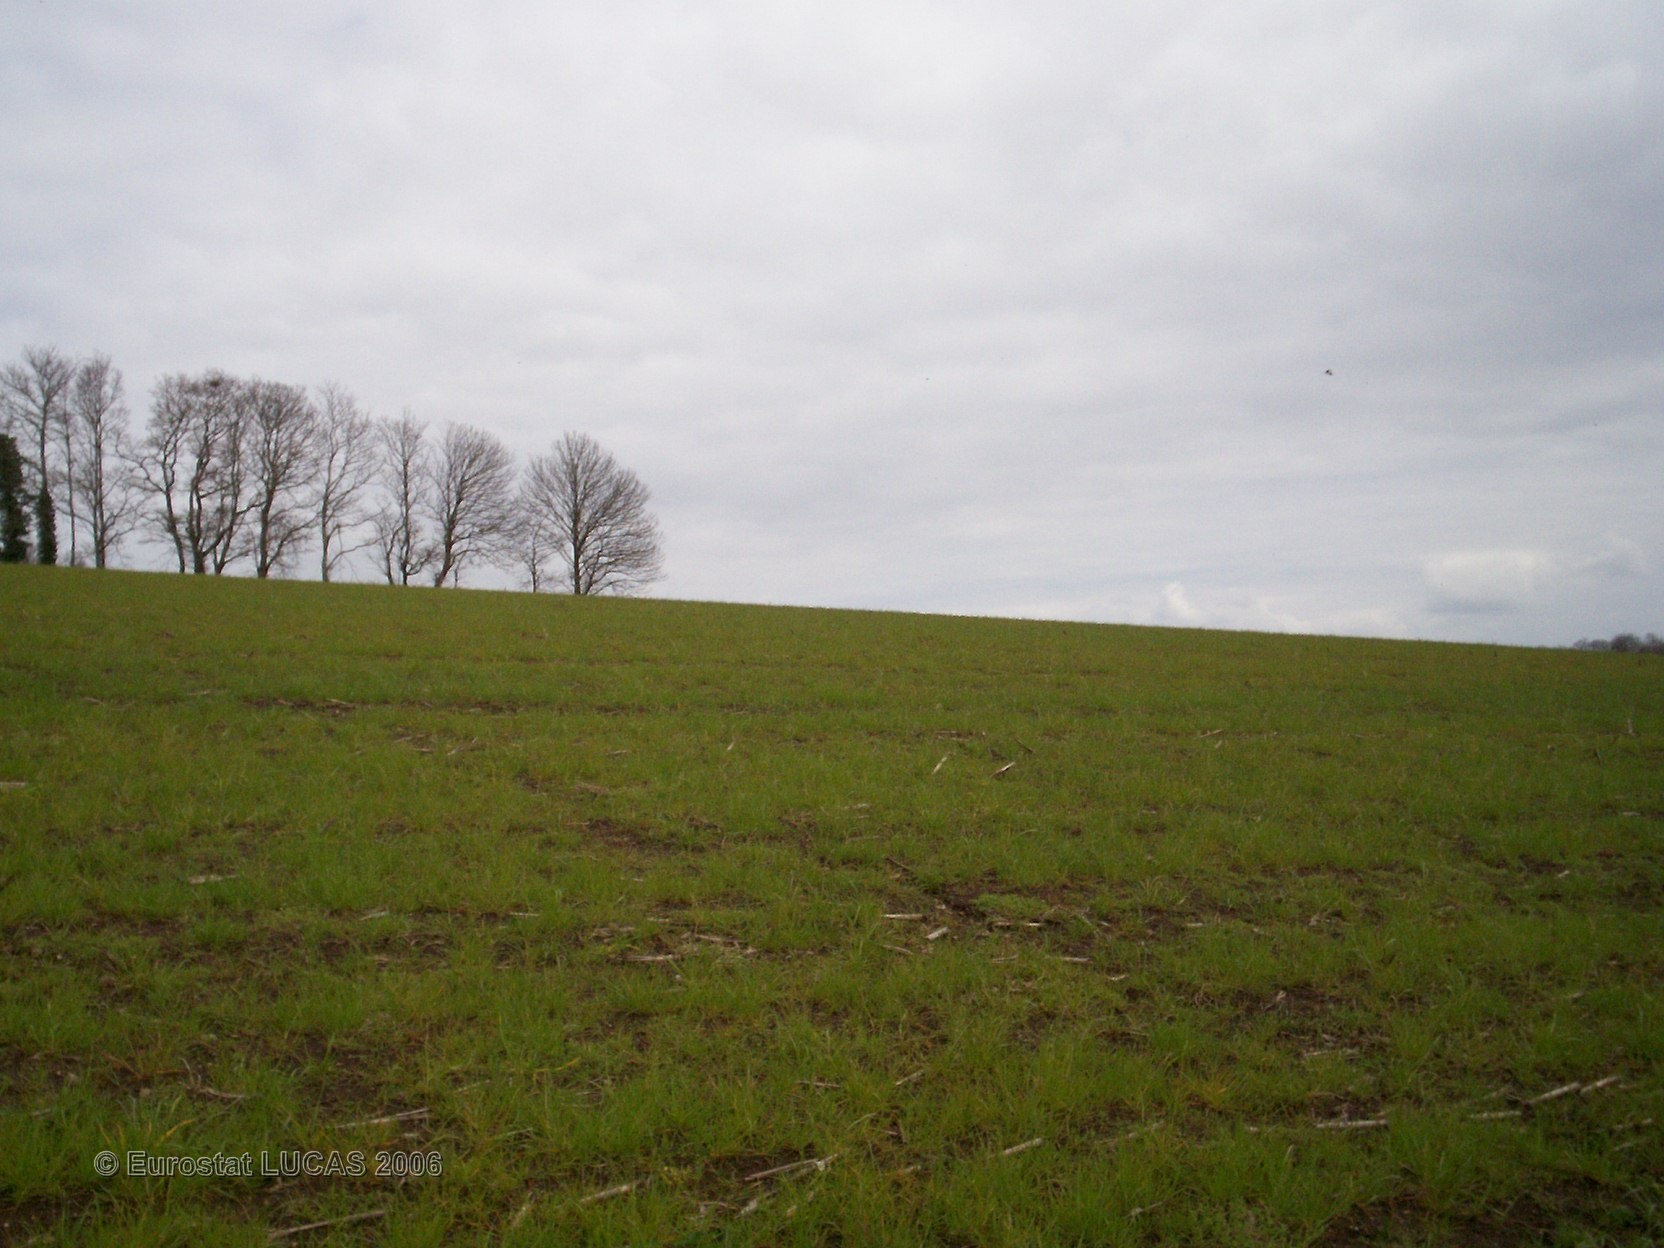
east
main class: Grassland
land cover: Grassland without tree/shrub cover
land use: Agriculture (excluding fallow land and kitchen gardens)
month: April
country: FR
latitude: 48.0027
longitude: -3.5478
